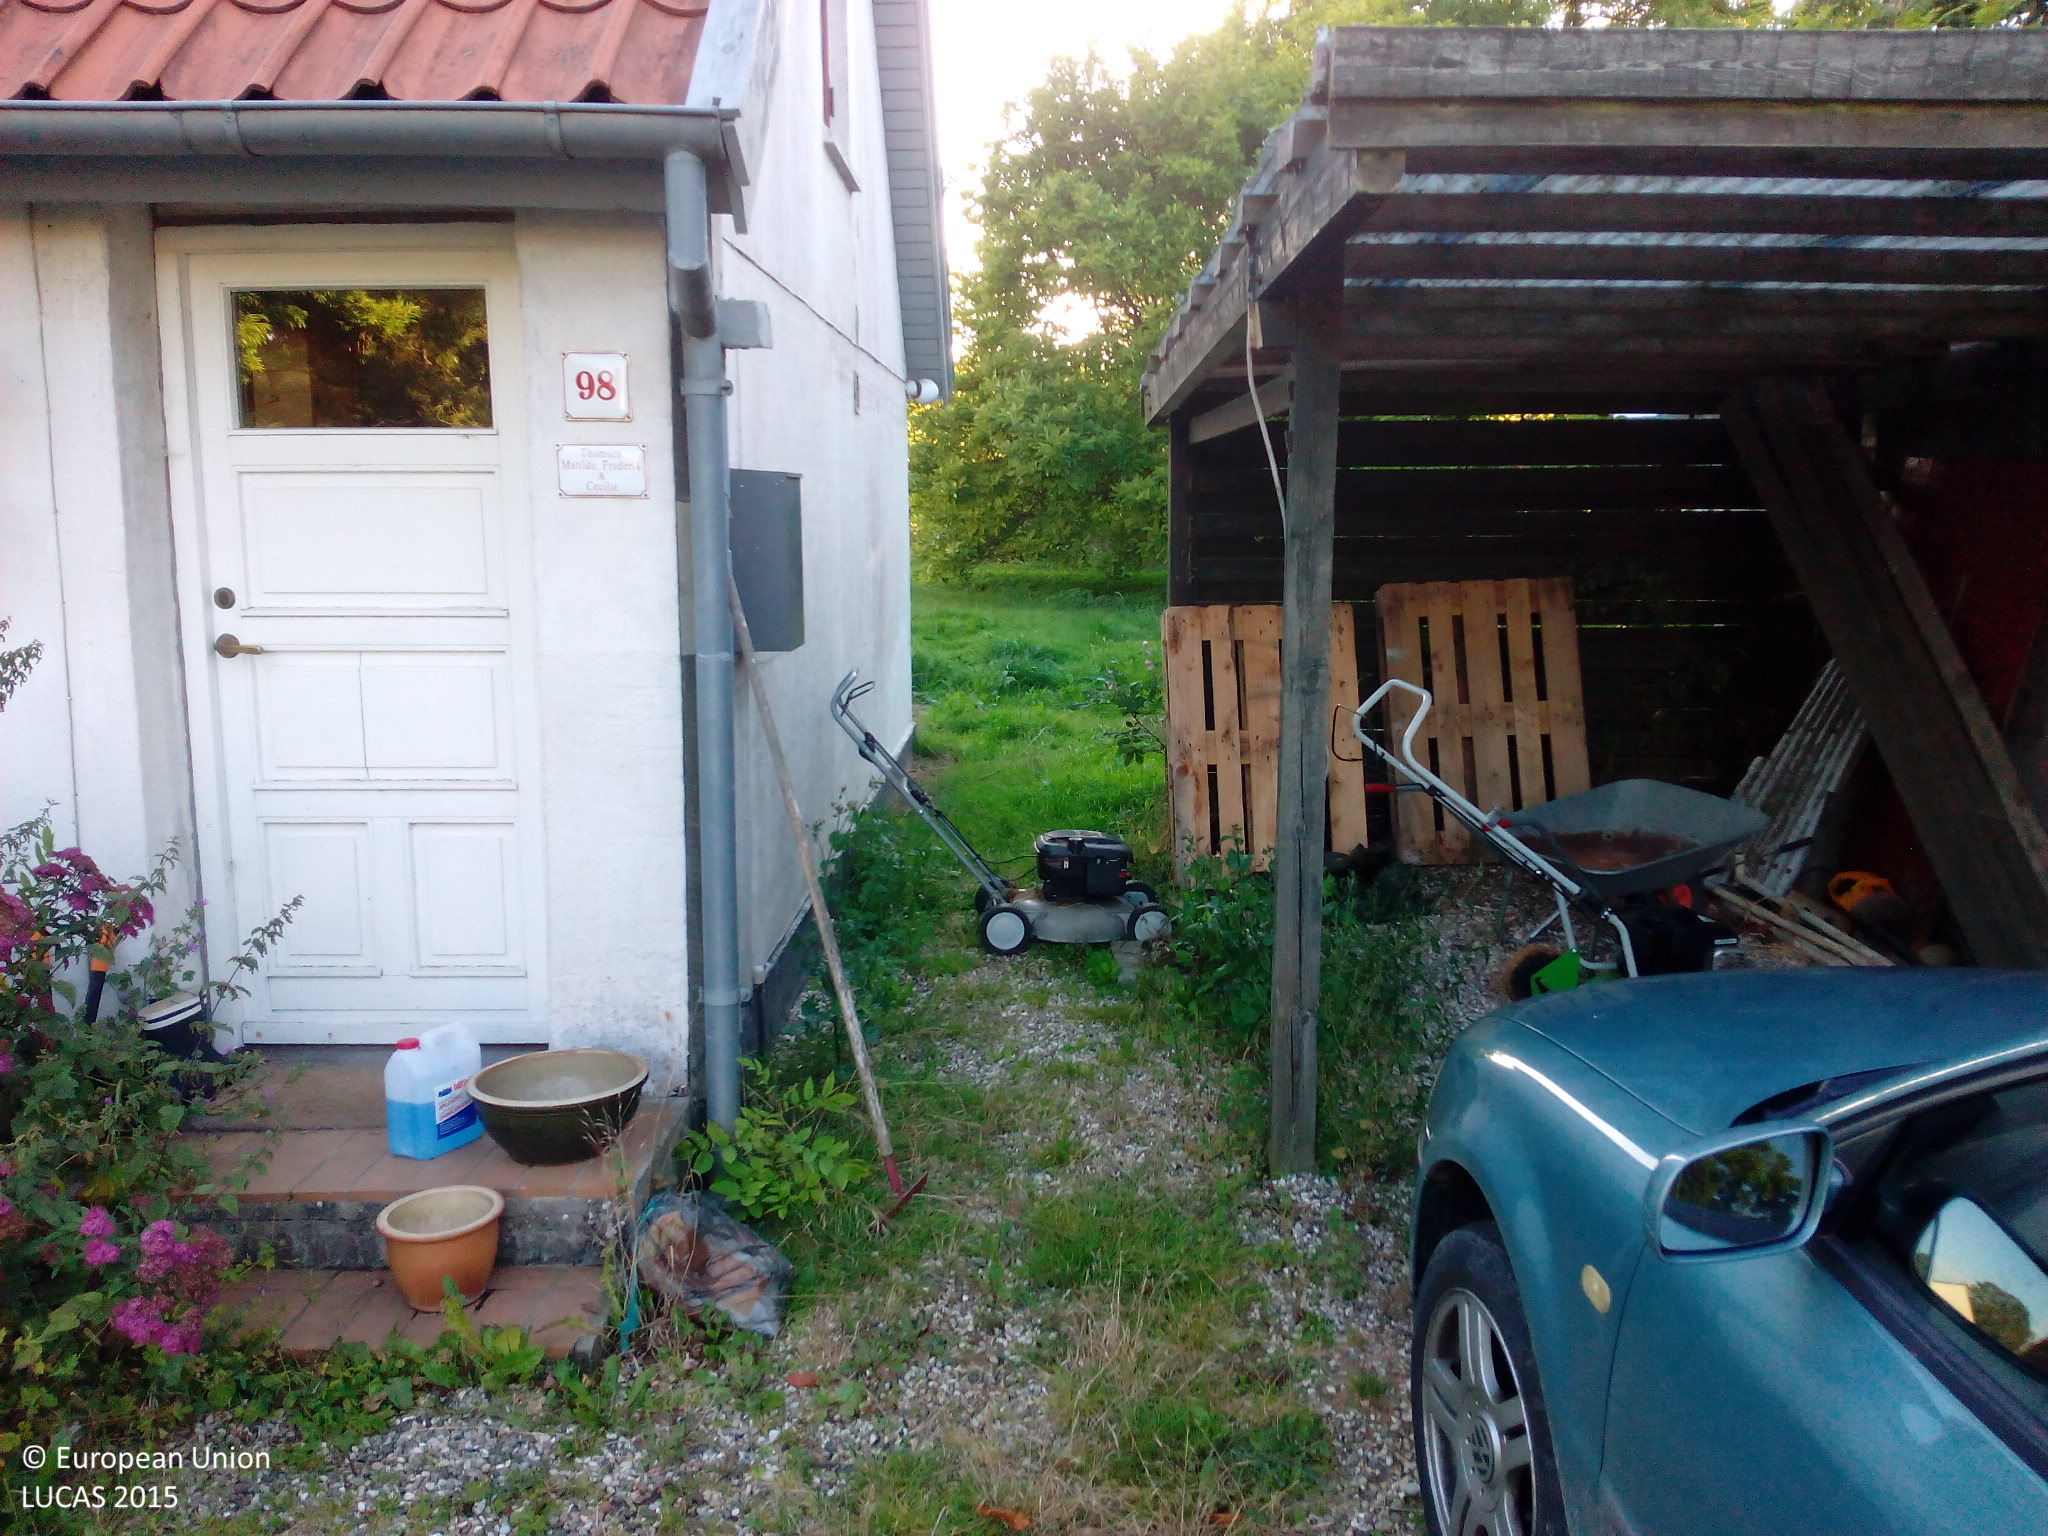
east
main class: Cropland
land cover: Common wheat
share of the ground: > 75 %
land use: Agriculture (excluding fallow land and kitchen gardens)
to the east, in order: Common wheat; Broadleaved woodland; Fences; Grassland without tree/shrub cover; Fences; Grassland without tree/shrub cover; Pine dominated mixed woodland; Grass margins; Artificial constructions in urban areas
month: August
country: DK
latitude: 55.5640
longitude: 11.7902
